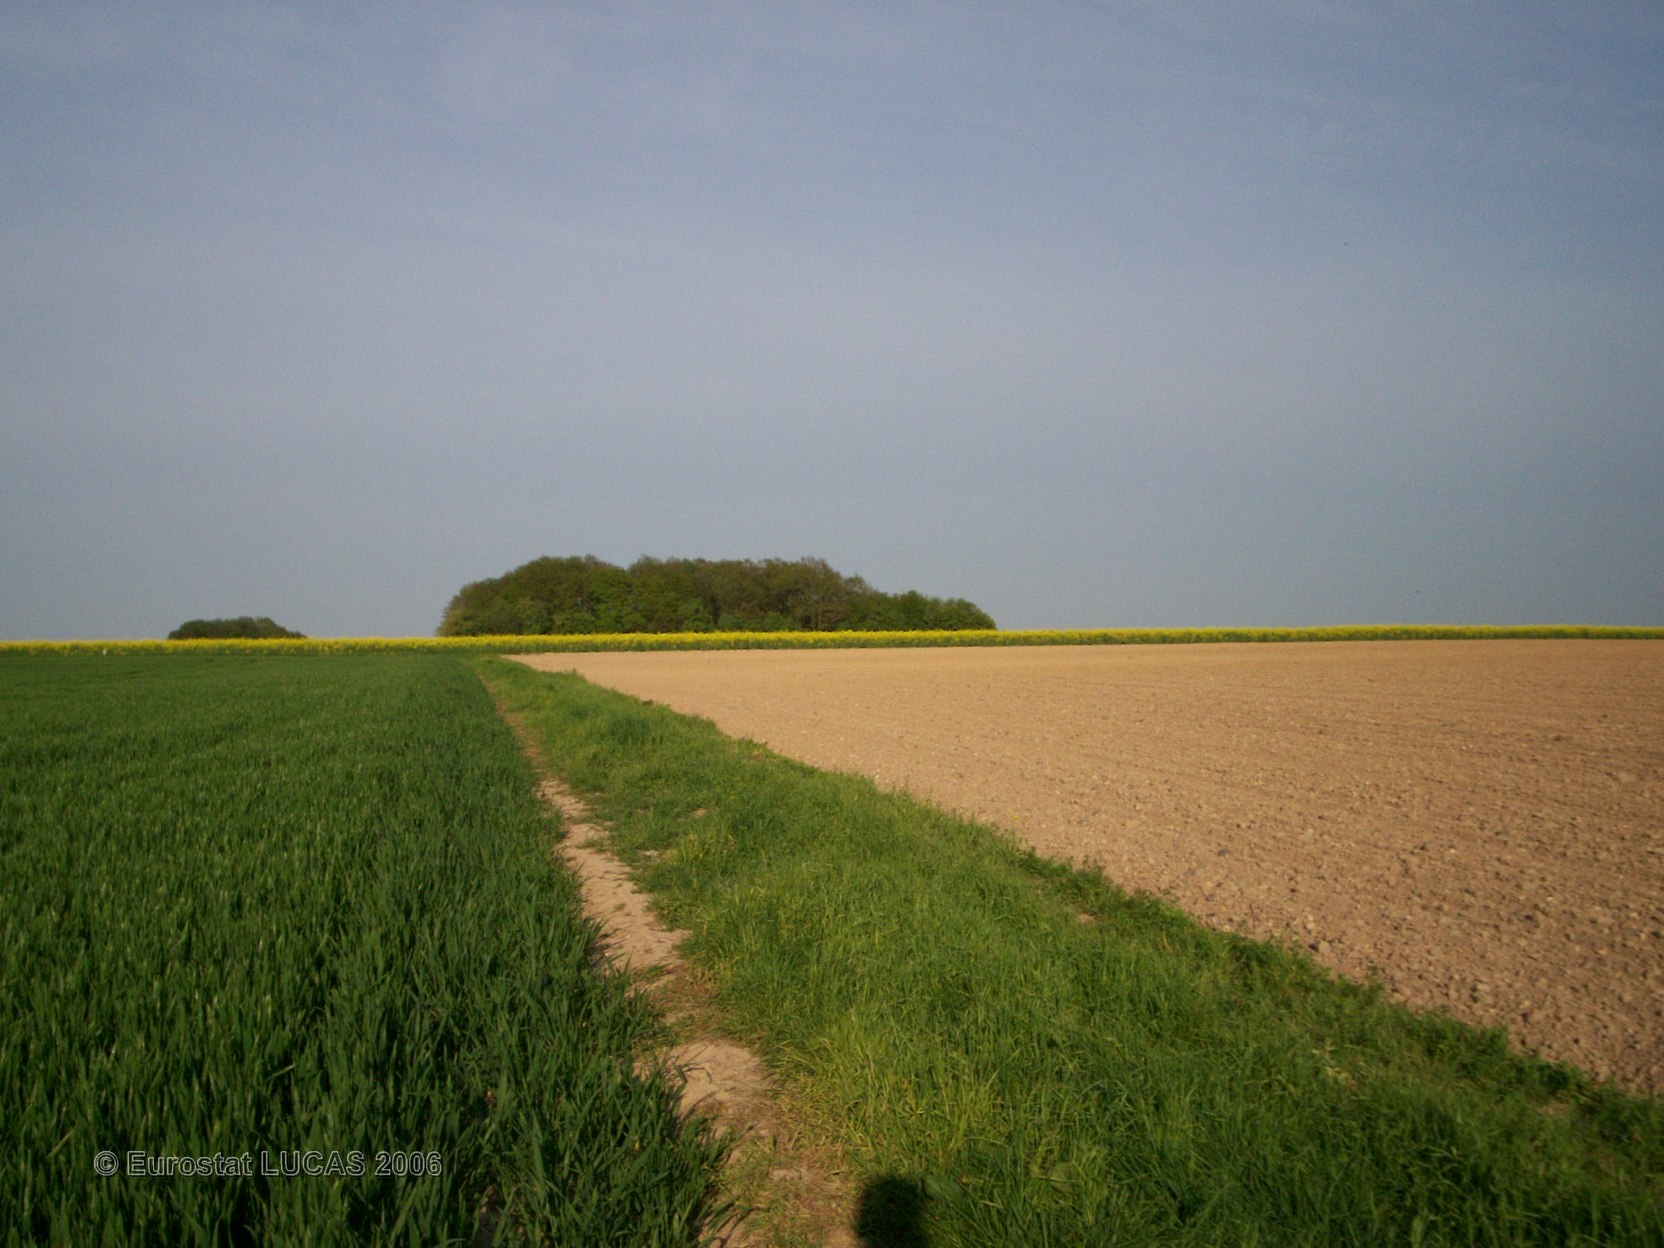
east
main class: Cropland
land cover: Common wheat
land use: Agriculture (excluding fallow land and kitchen gardens)
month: May
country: FR
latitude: 48.1968
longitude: 2.9560
